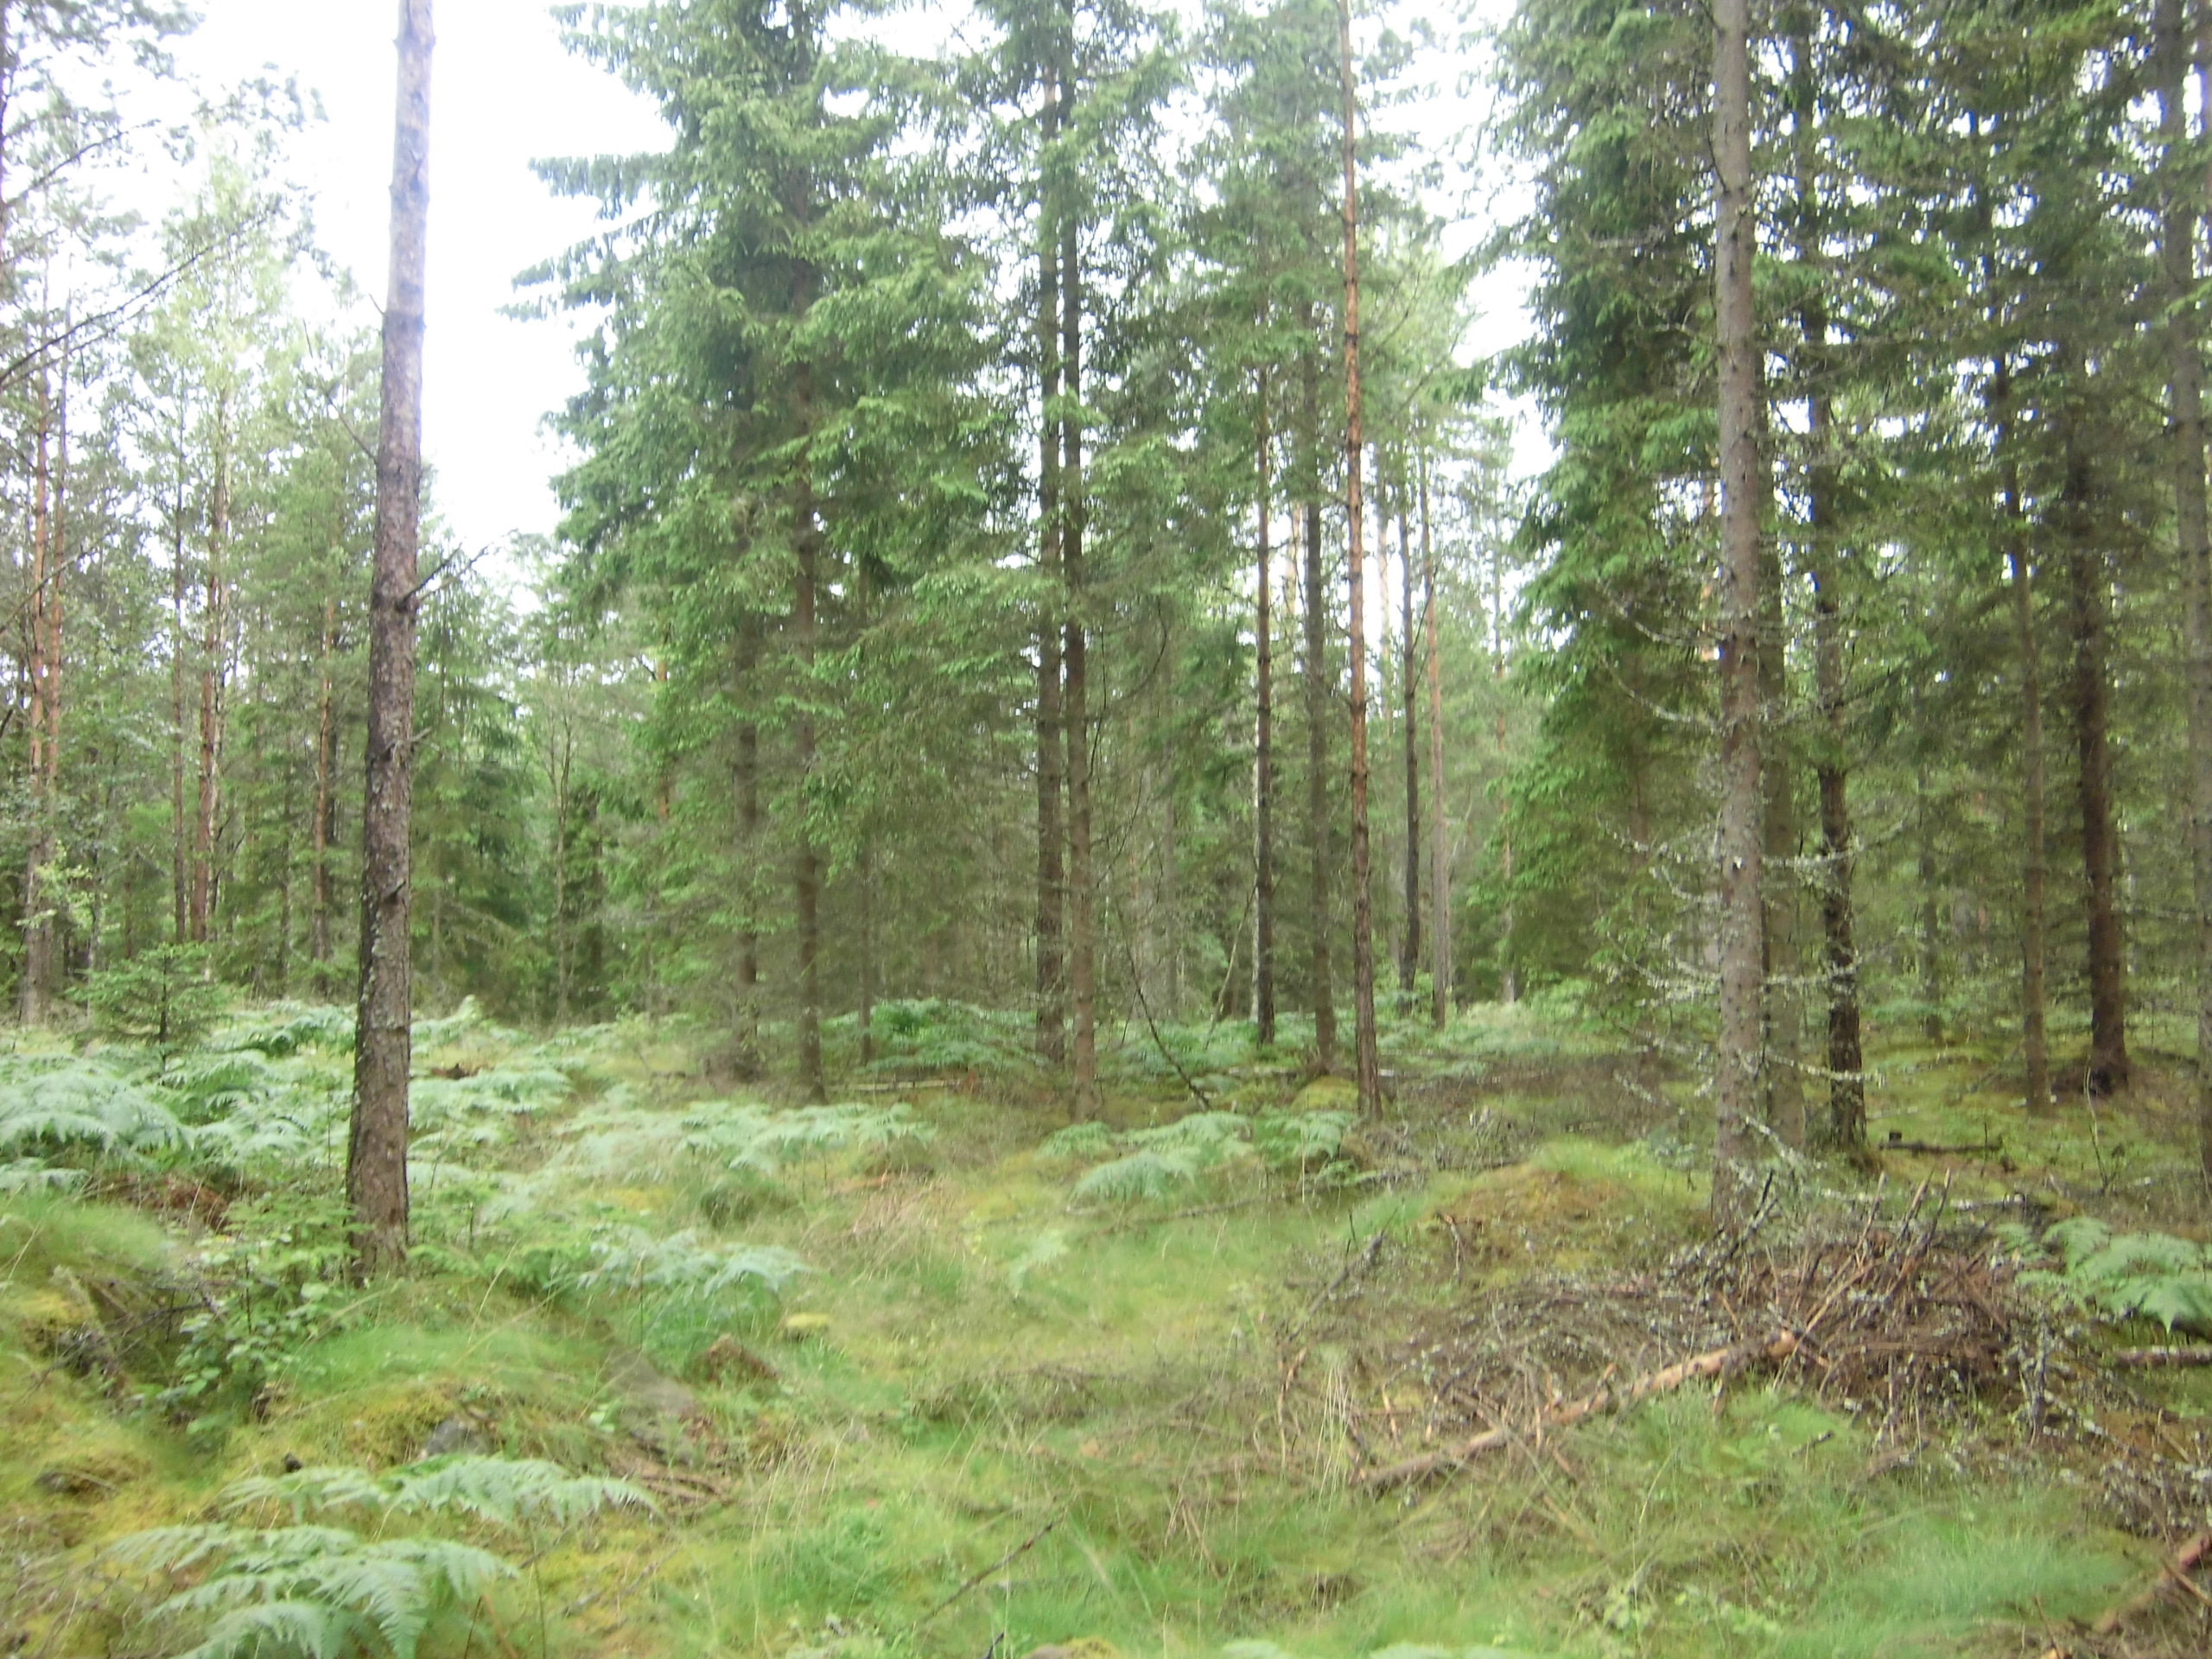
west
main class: Woodland
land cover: Spruce dominated coniferous woodland
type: boreal forest
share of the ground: 50 - 75 %
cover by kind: coniferous forest trees 55 %, lichens and mosses 20 %, herbaceous plants 15 %, broadleaved forest trees 5 %, shrubs 5 %
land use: Forestry
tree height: > 5 m
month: July
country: SE
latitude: 57.1402
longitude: 15.3349
